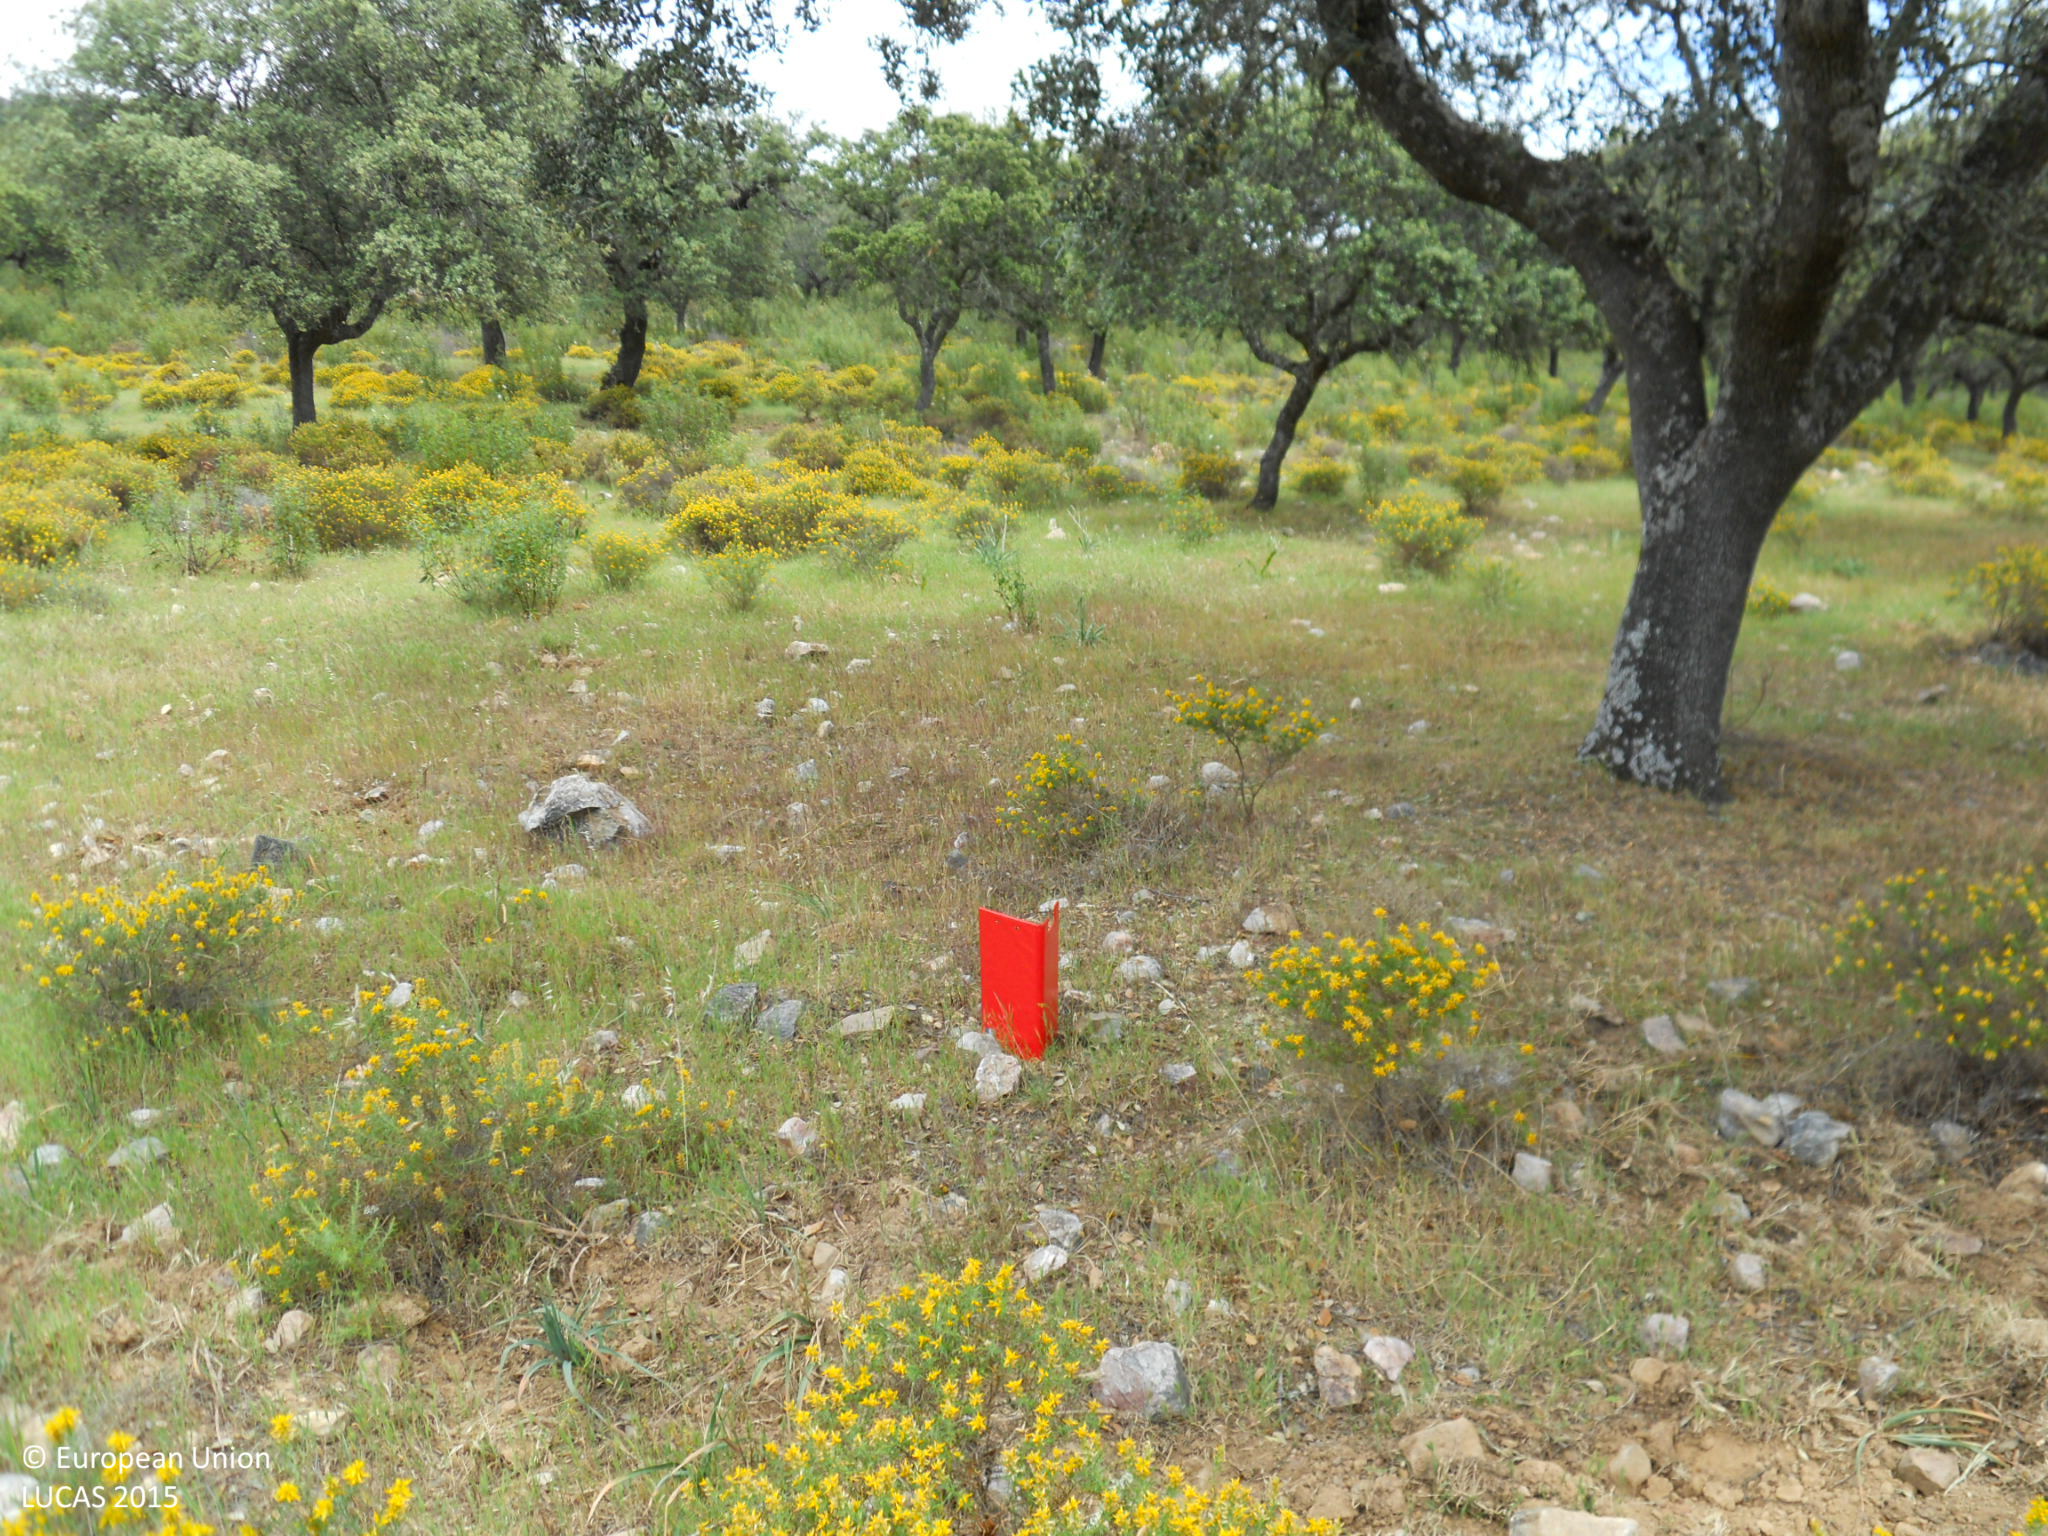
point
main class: Woodland
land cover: Broadleaved woodland
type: broadleaved evergreen forest
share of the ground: 25 - 50 %
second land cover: Shrubland without tree cover
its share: > 75 %
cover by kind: broadleaved forest trees 90 %, shrubs 5 %, herbaceous plants 5 %
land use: Forestry
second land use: Agriculture (excluding fallow land and kitchen gardens)
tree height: > 5 m
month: April
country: ES
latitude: 39.3266
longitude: -6.8848
